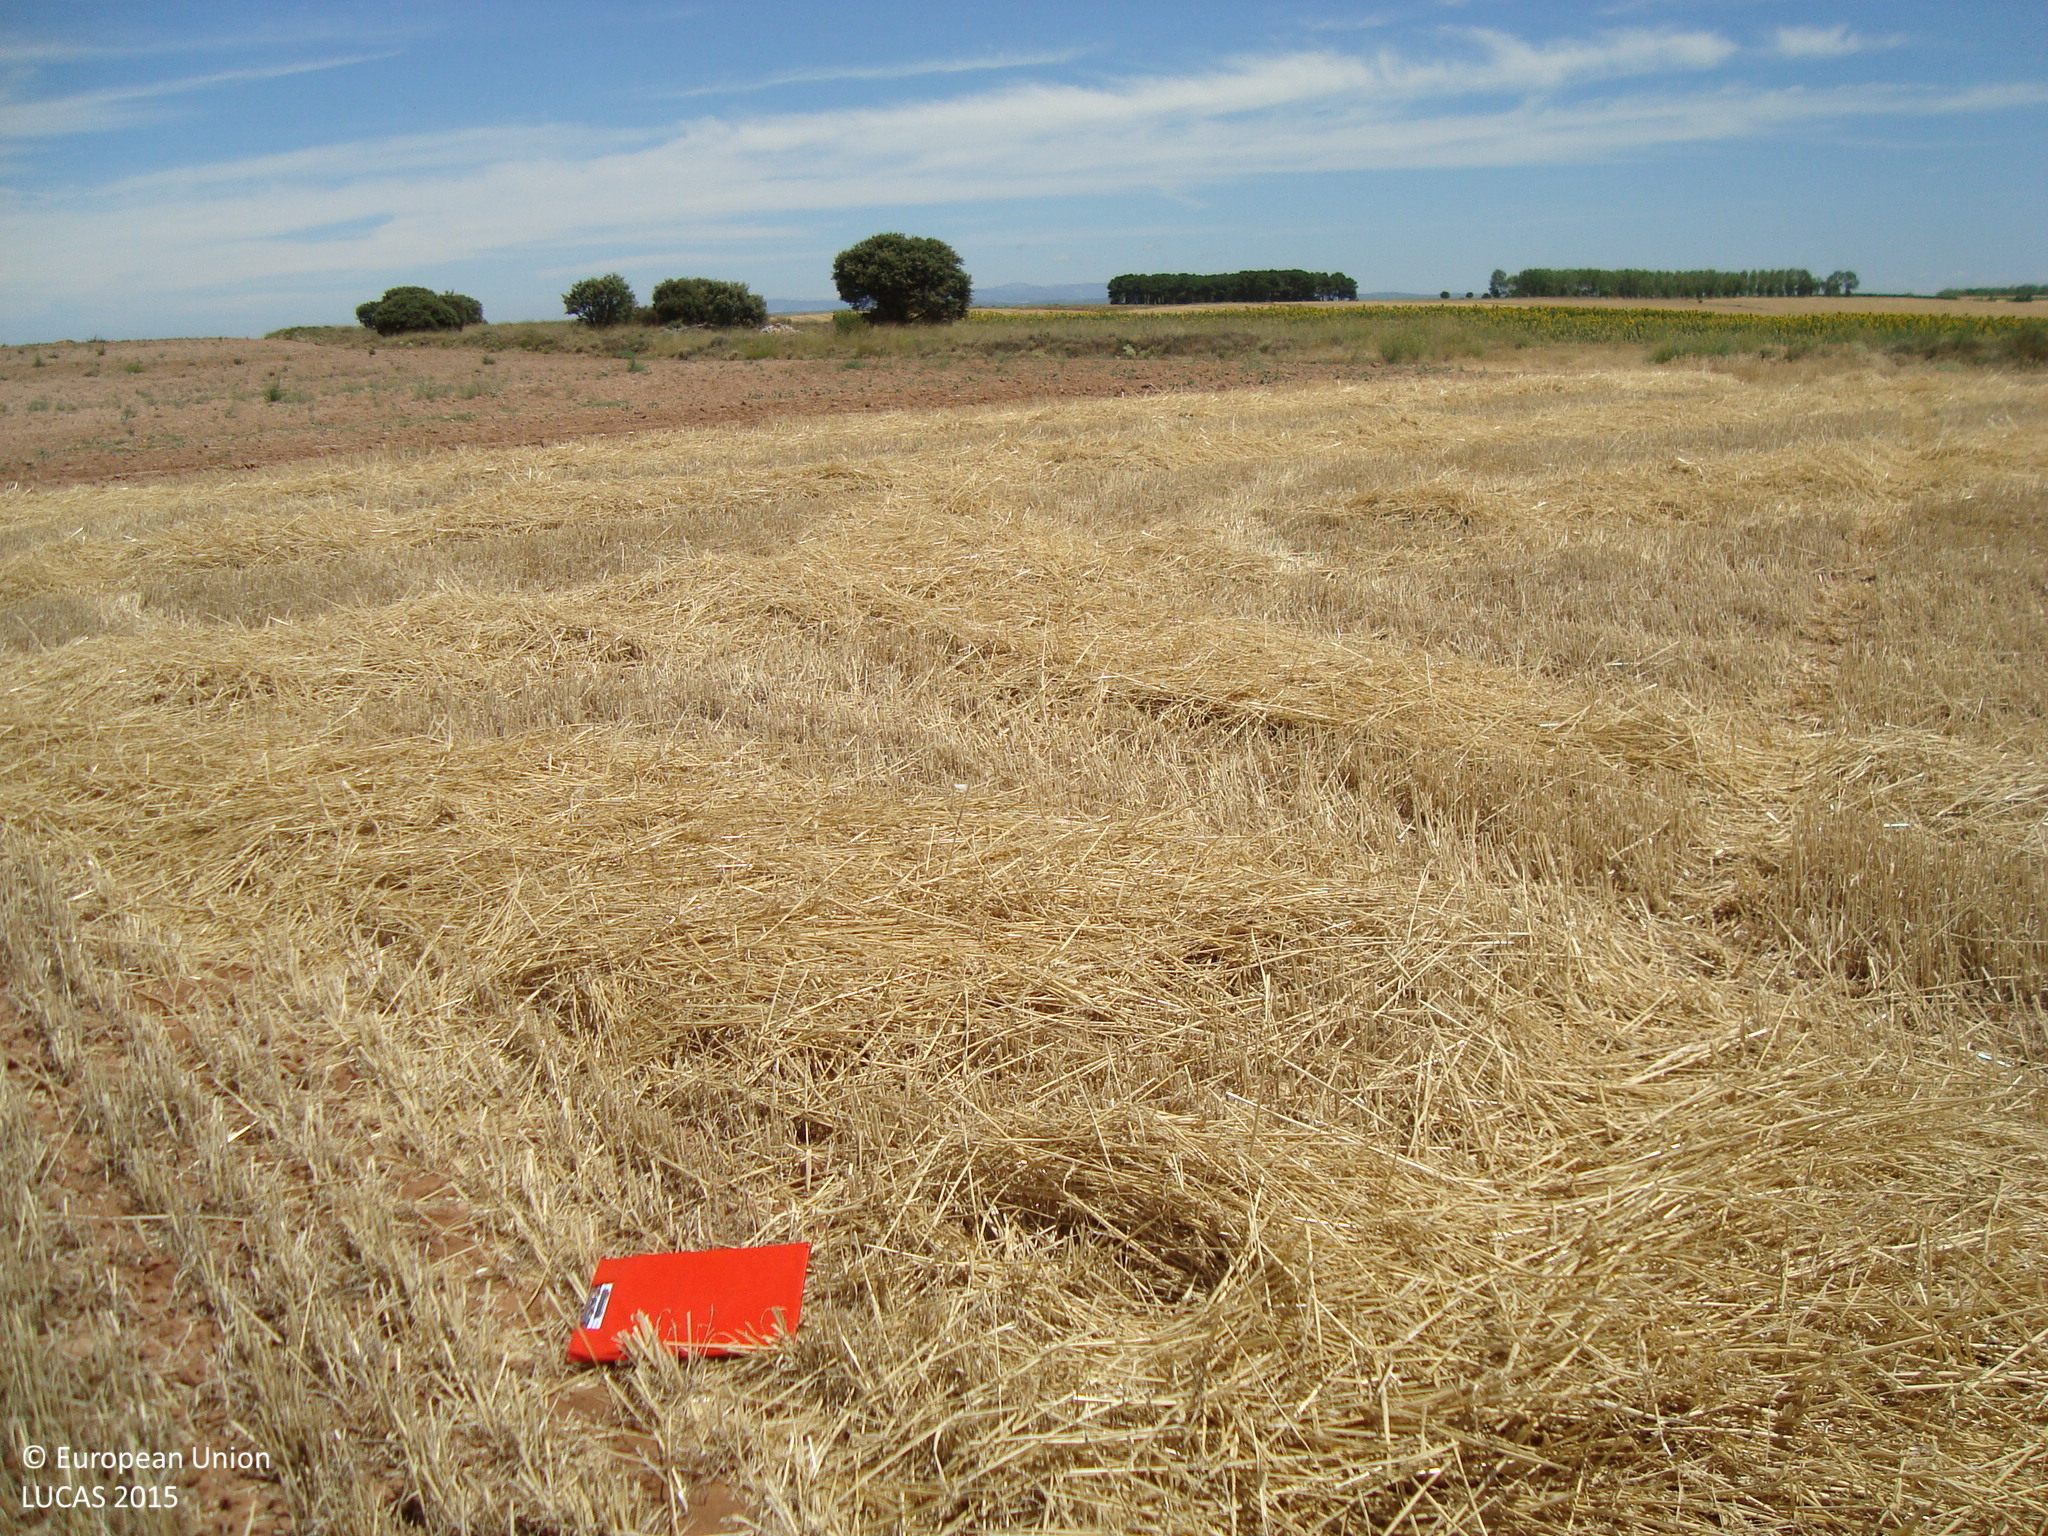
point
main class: Cropland
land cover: Common wheat
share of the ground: > 75 %
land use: Agriculture (excluding fallow land and kitchen gardens)
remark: Harvested field
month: July
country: ES
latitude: 42.0990
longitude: -3.8567
